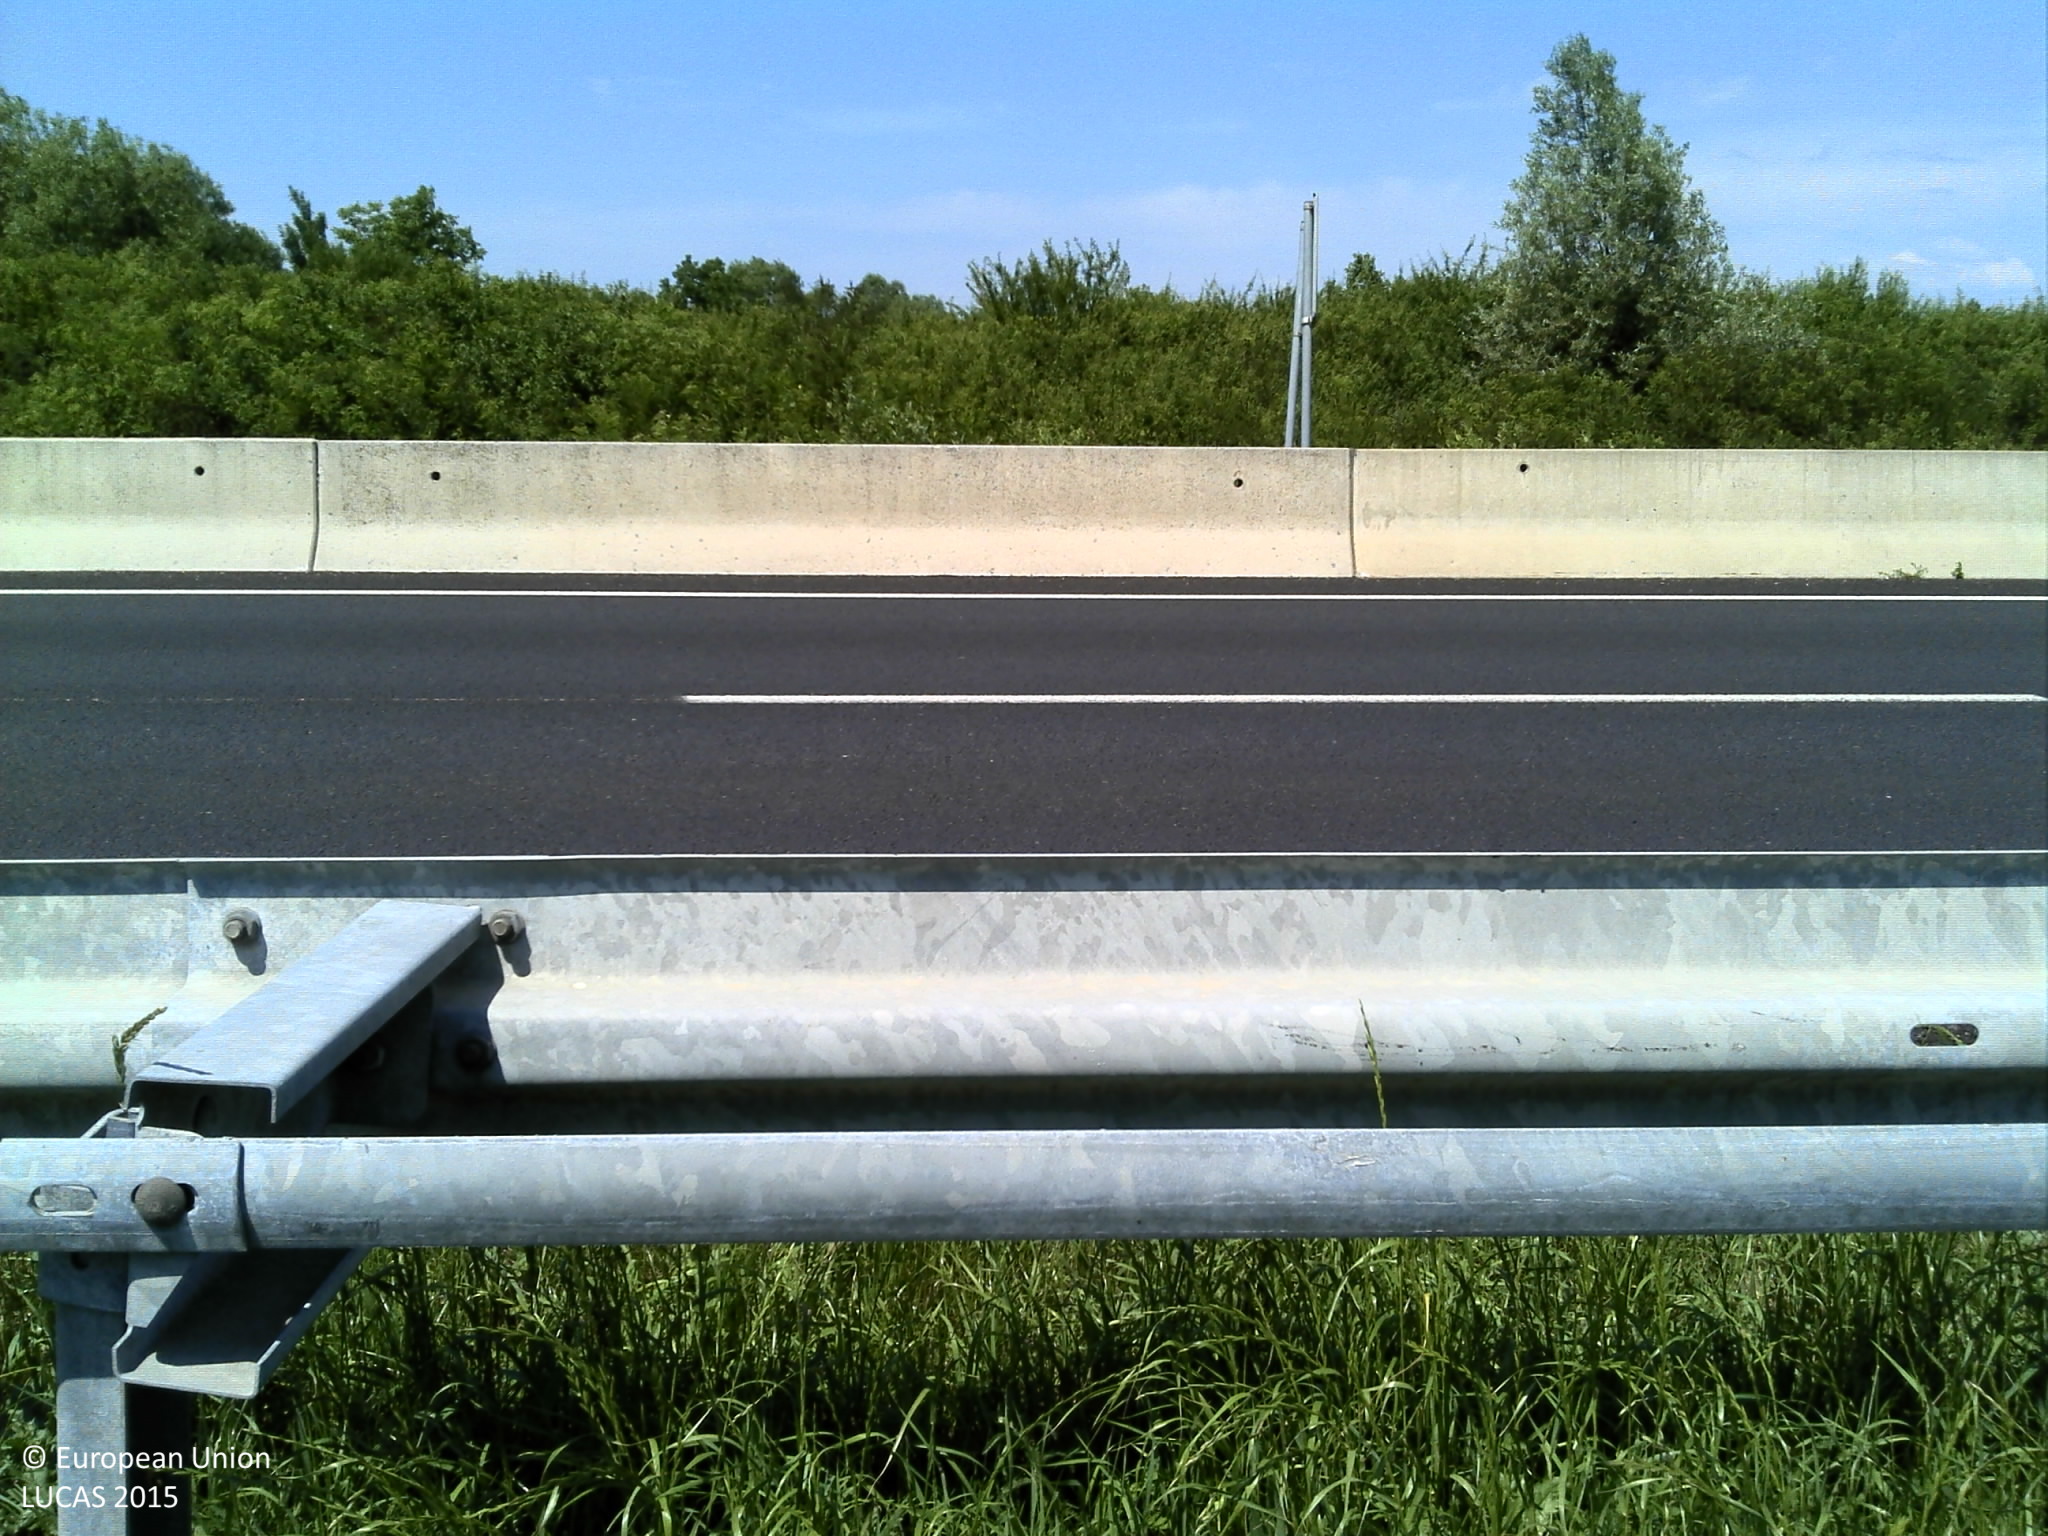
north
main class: Grassland
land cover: Spontaneously vegetated surfaces
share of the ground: > 75 %
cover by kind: herbaceous plants 100 %
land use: Fallow land
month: June
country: HR
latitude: 45.1659
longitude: 17.9794
